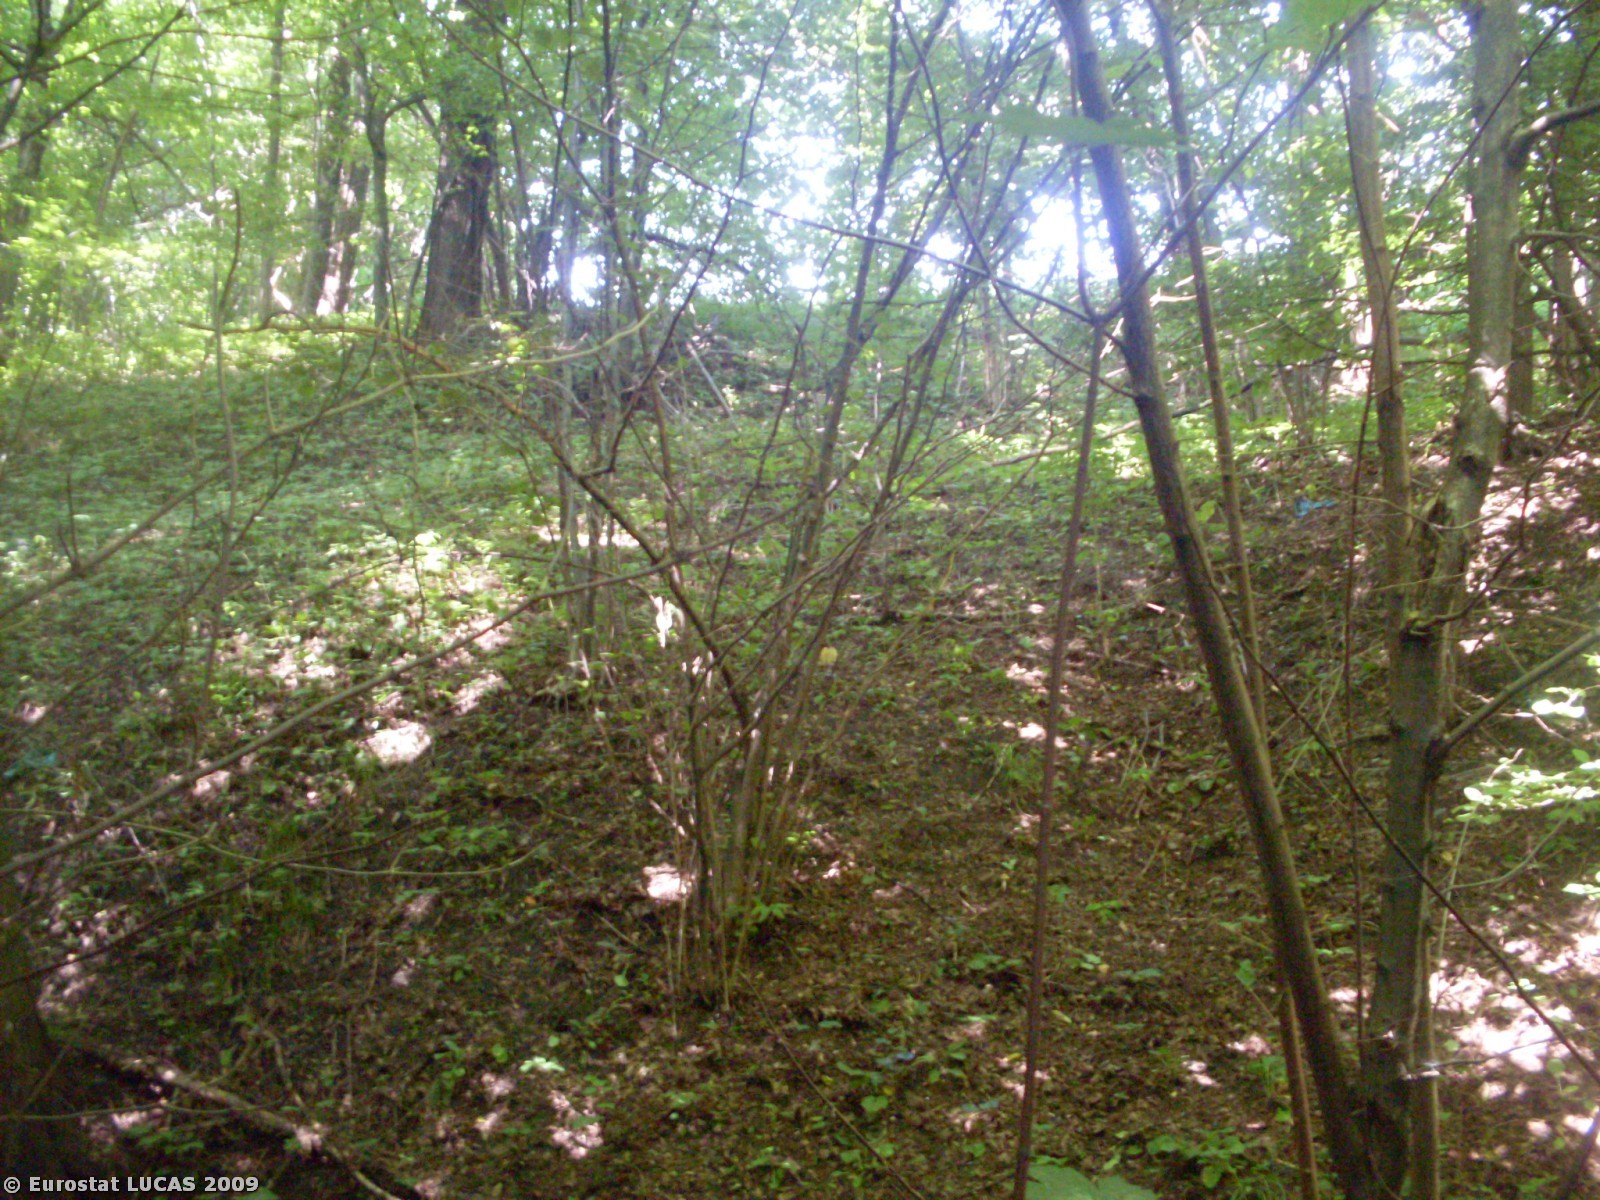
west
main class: Woodland
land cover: Broadleaved woodland
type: mesophytic deciduous forest
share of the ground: > 75 %
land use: Unused
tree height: > 5 m
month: July
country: PL
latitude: 49.7915
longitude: 20.2724
